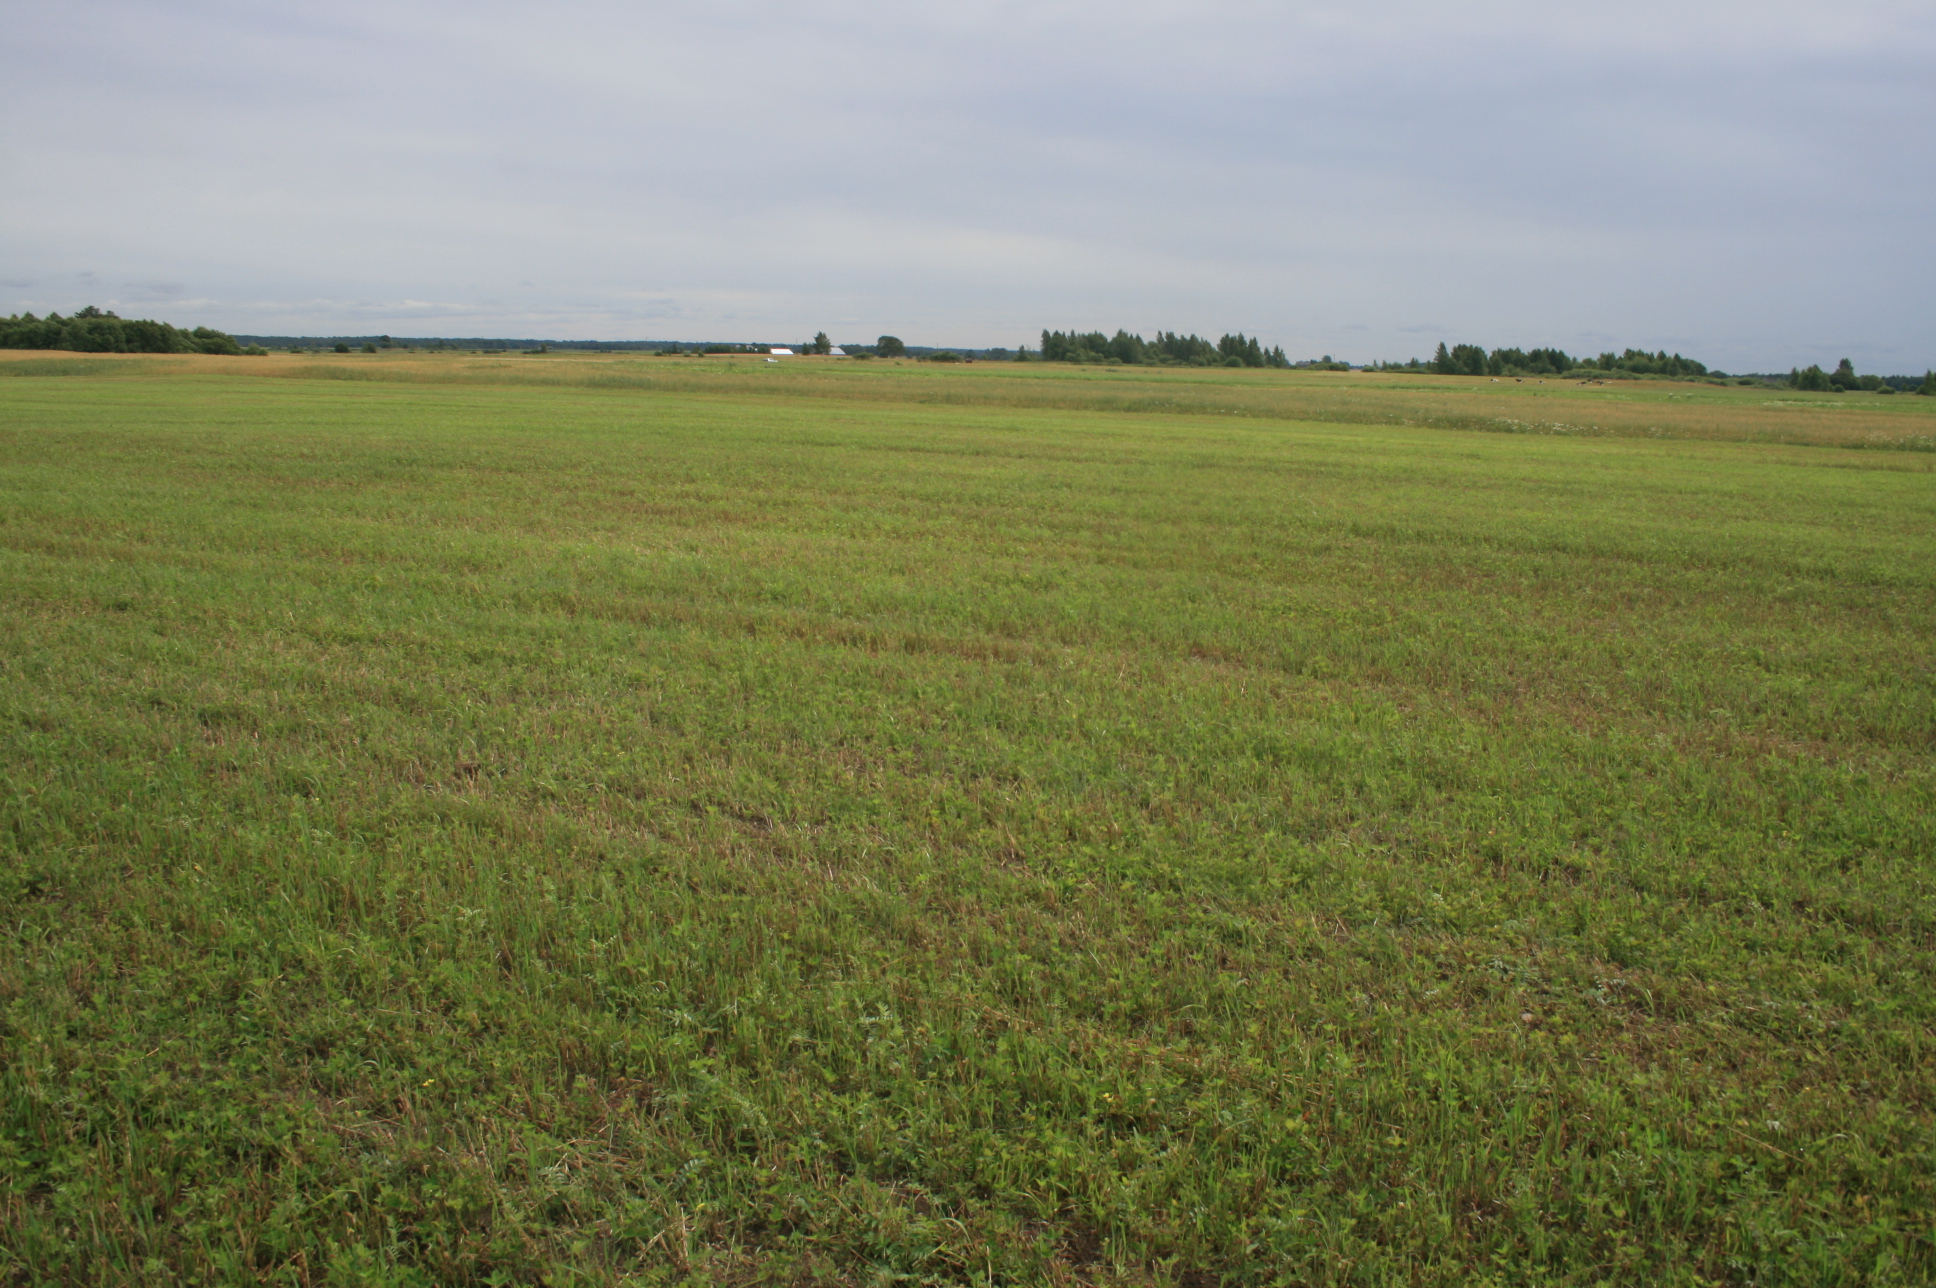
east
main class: Cropland
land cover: Other leguminous and mixtures for fodder
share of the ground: > 75 %
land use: Agriculture (excluding fallow land and kitchen gardens)
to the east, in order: Other leguminous and mixtures for fodder; Oats; Potatoes; Other leguminous and mixtures for fodder; Clovers
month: July
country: LT
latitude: 55.2940
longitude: 22.0069
